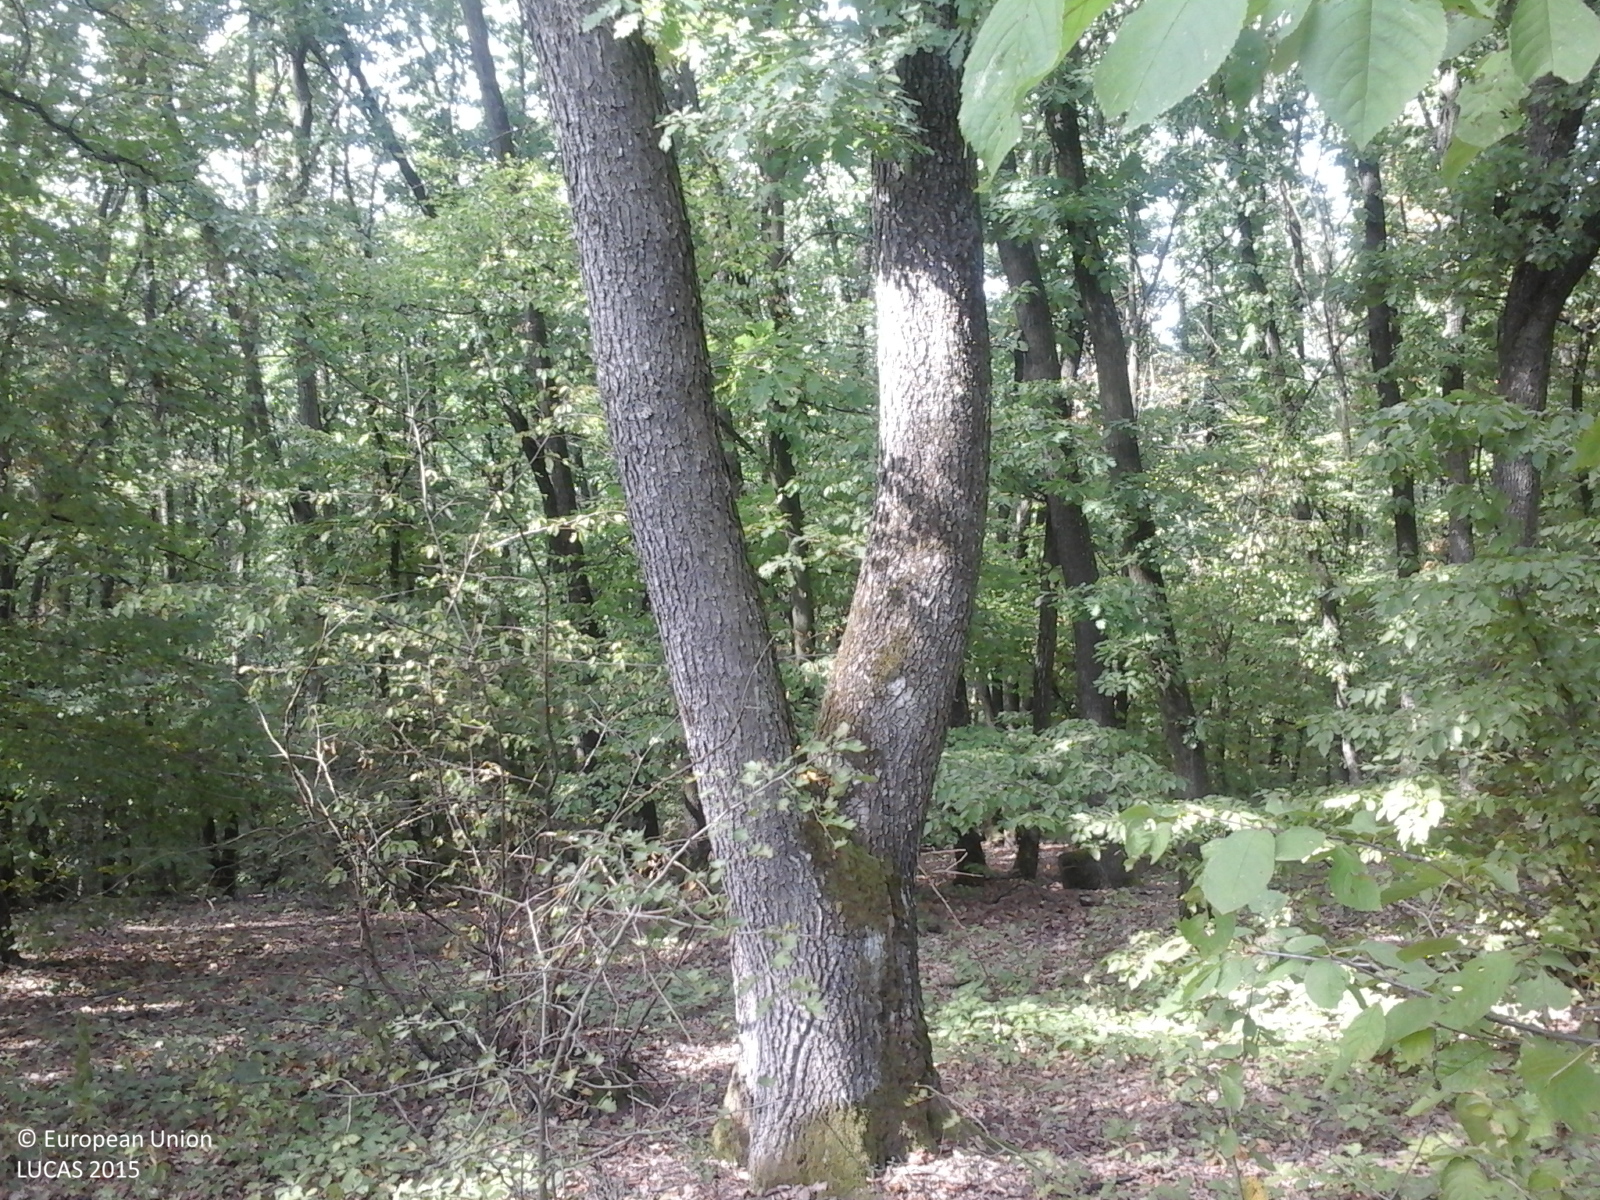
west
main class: Woodland
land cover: Broadleaved woodland
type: acidophilous oak and oak-birch forest
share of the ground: > 75 %
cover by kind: broadleaved forest trees 100 %
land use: Forestry
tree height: > 5 m
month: September
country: RO
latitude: 47.1261
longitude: 23.2627
